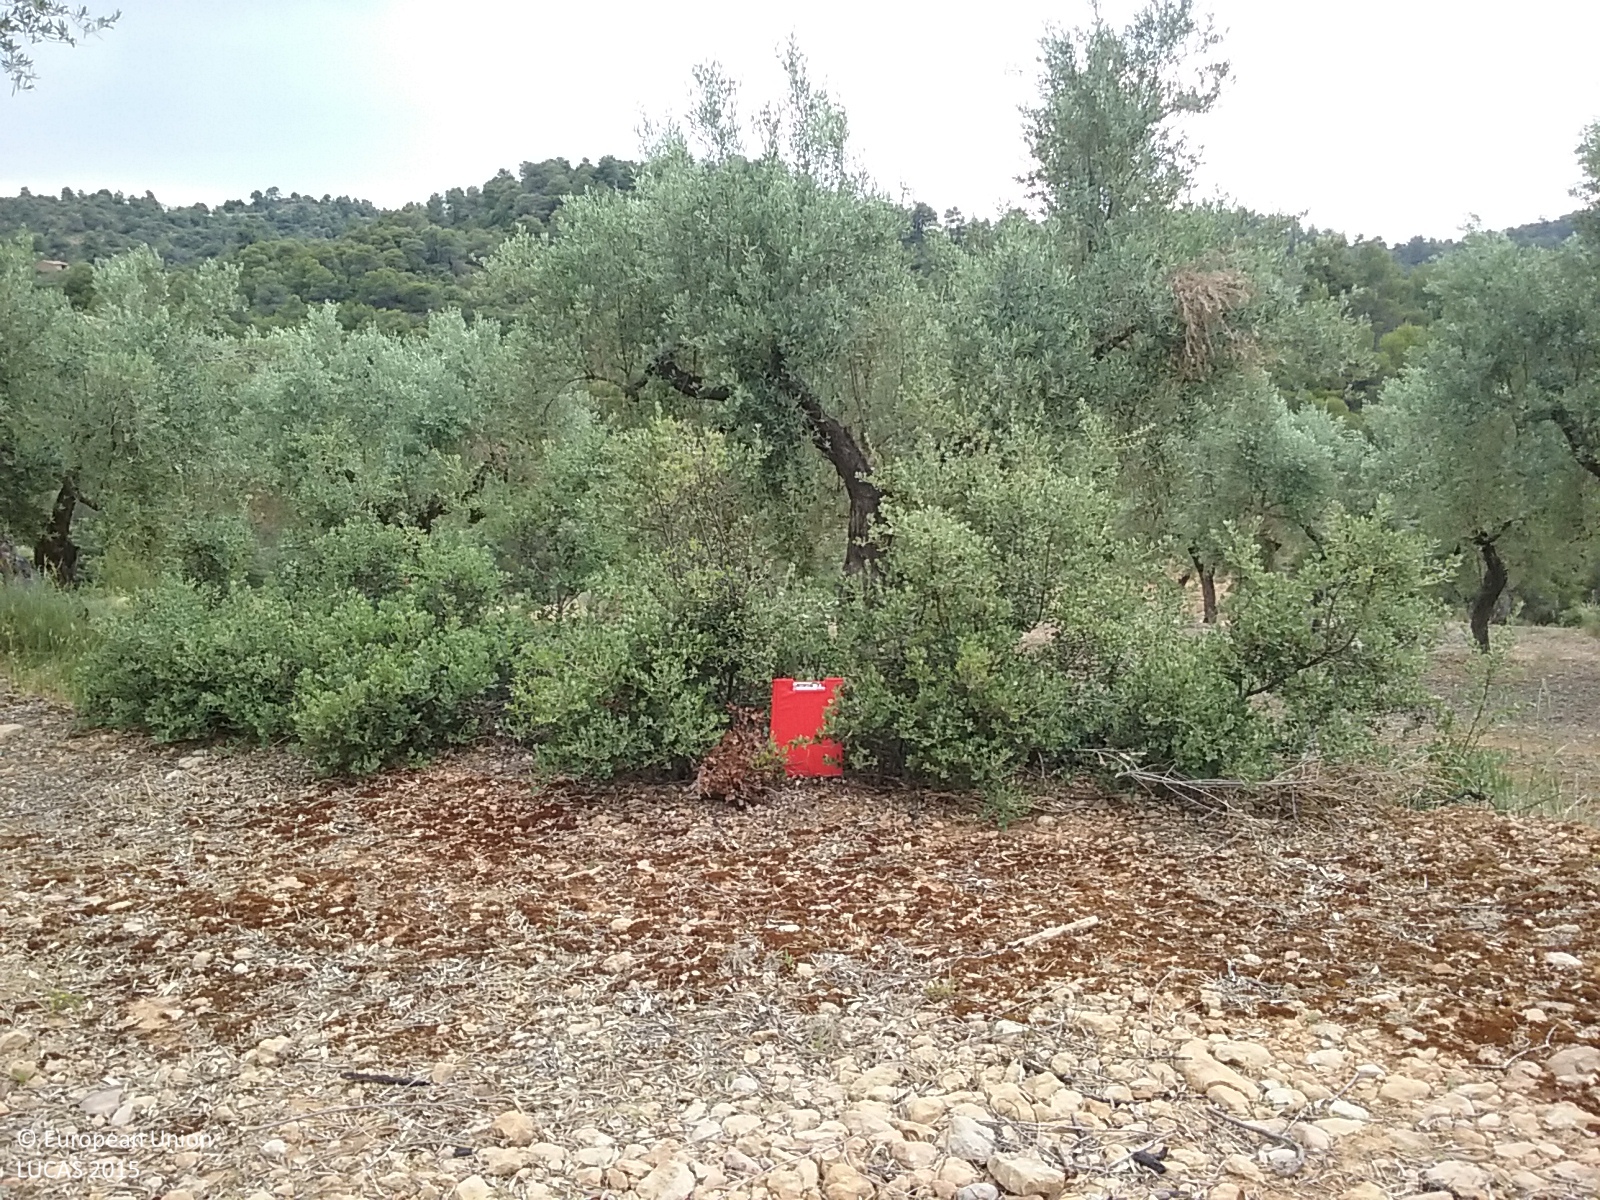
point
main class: Cropland
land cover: Olive groves
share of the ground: 50 - 75 %
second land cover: Other bare soil
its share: > 75 %
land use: Agriculture (excluding fallow land and kitchen gardens)
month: June
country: ES
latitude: 40.8684
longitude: 0.2034
